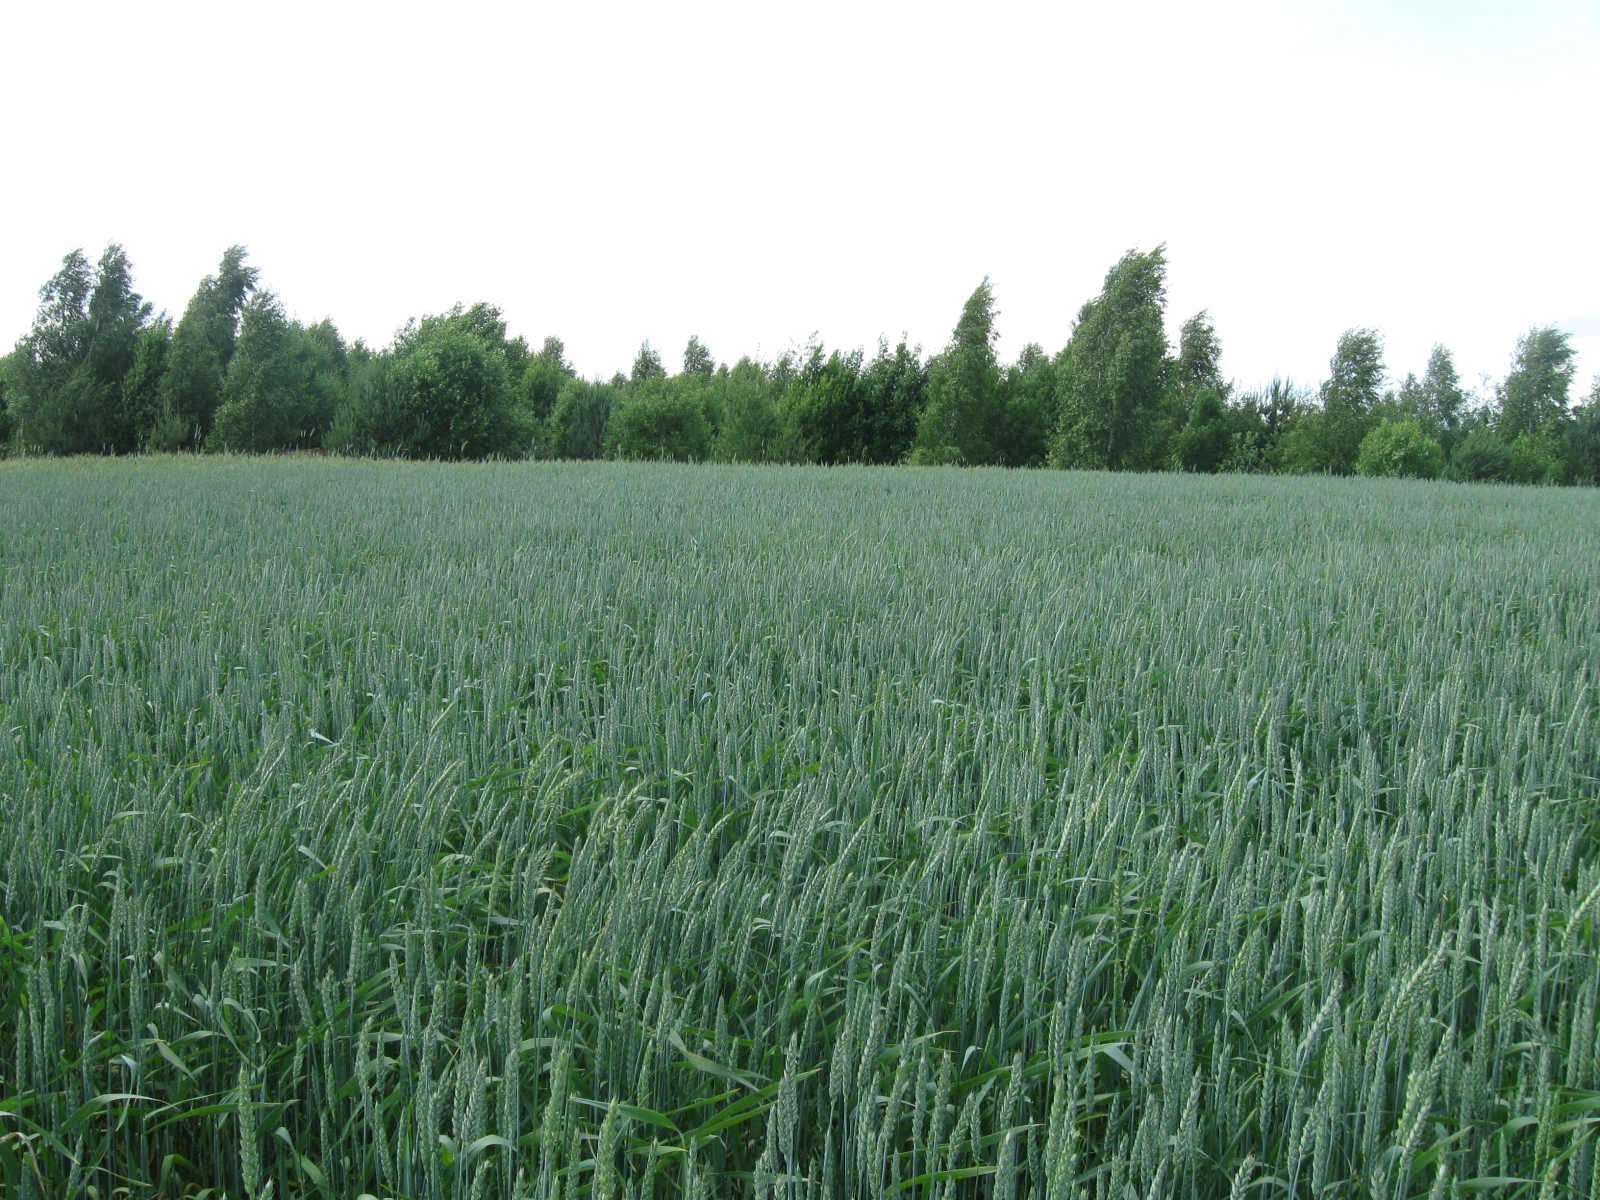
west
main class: Cropland
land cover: Common wheat
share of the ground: > 75 %
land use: Agriculture (excluding fallow land and kitchen gardens)
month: June
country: LT
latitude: 54.6516
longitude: 24.4377
